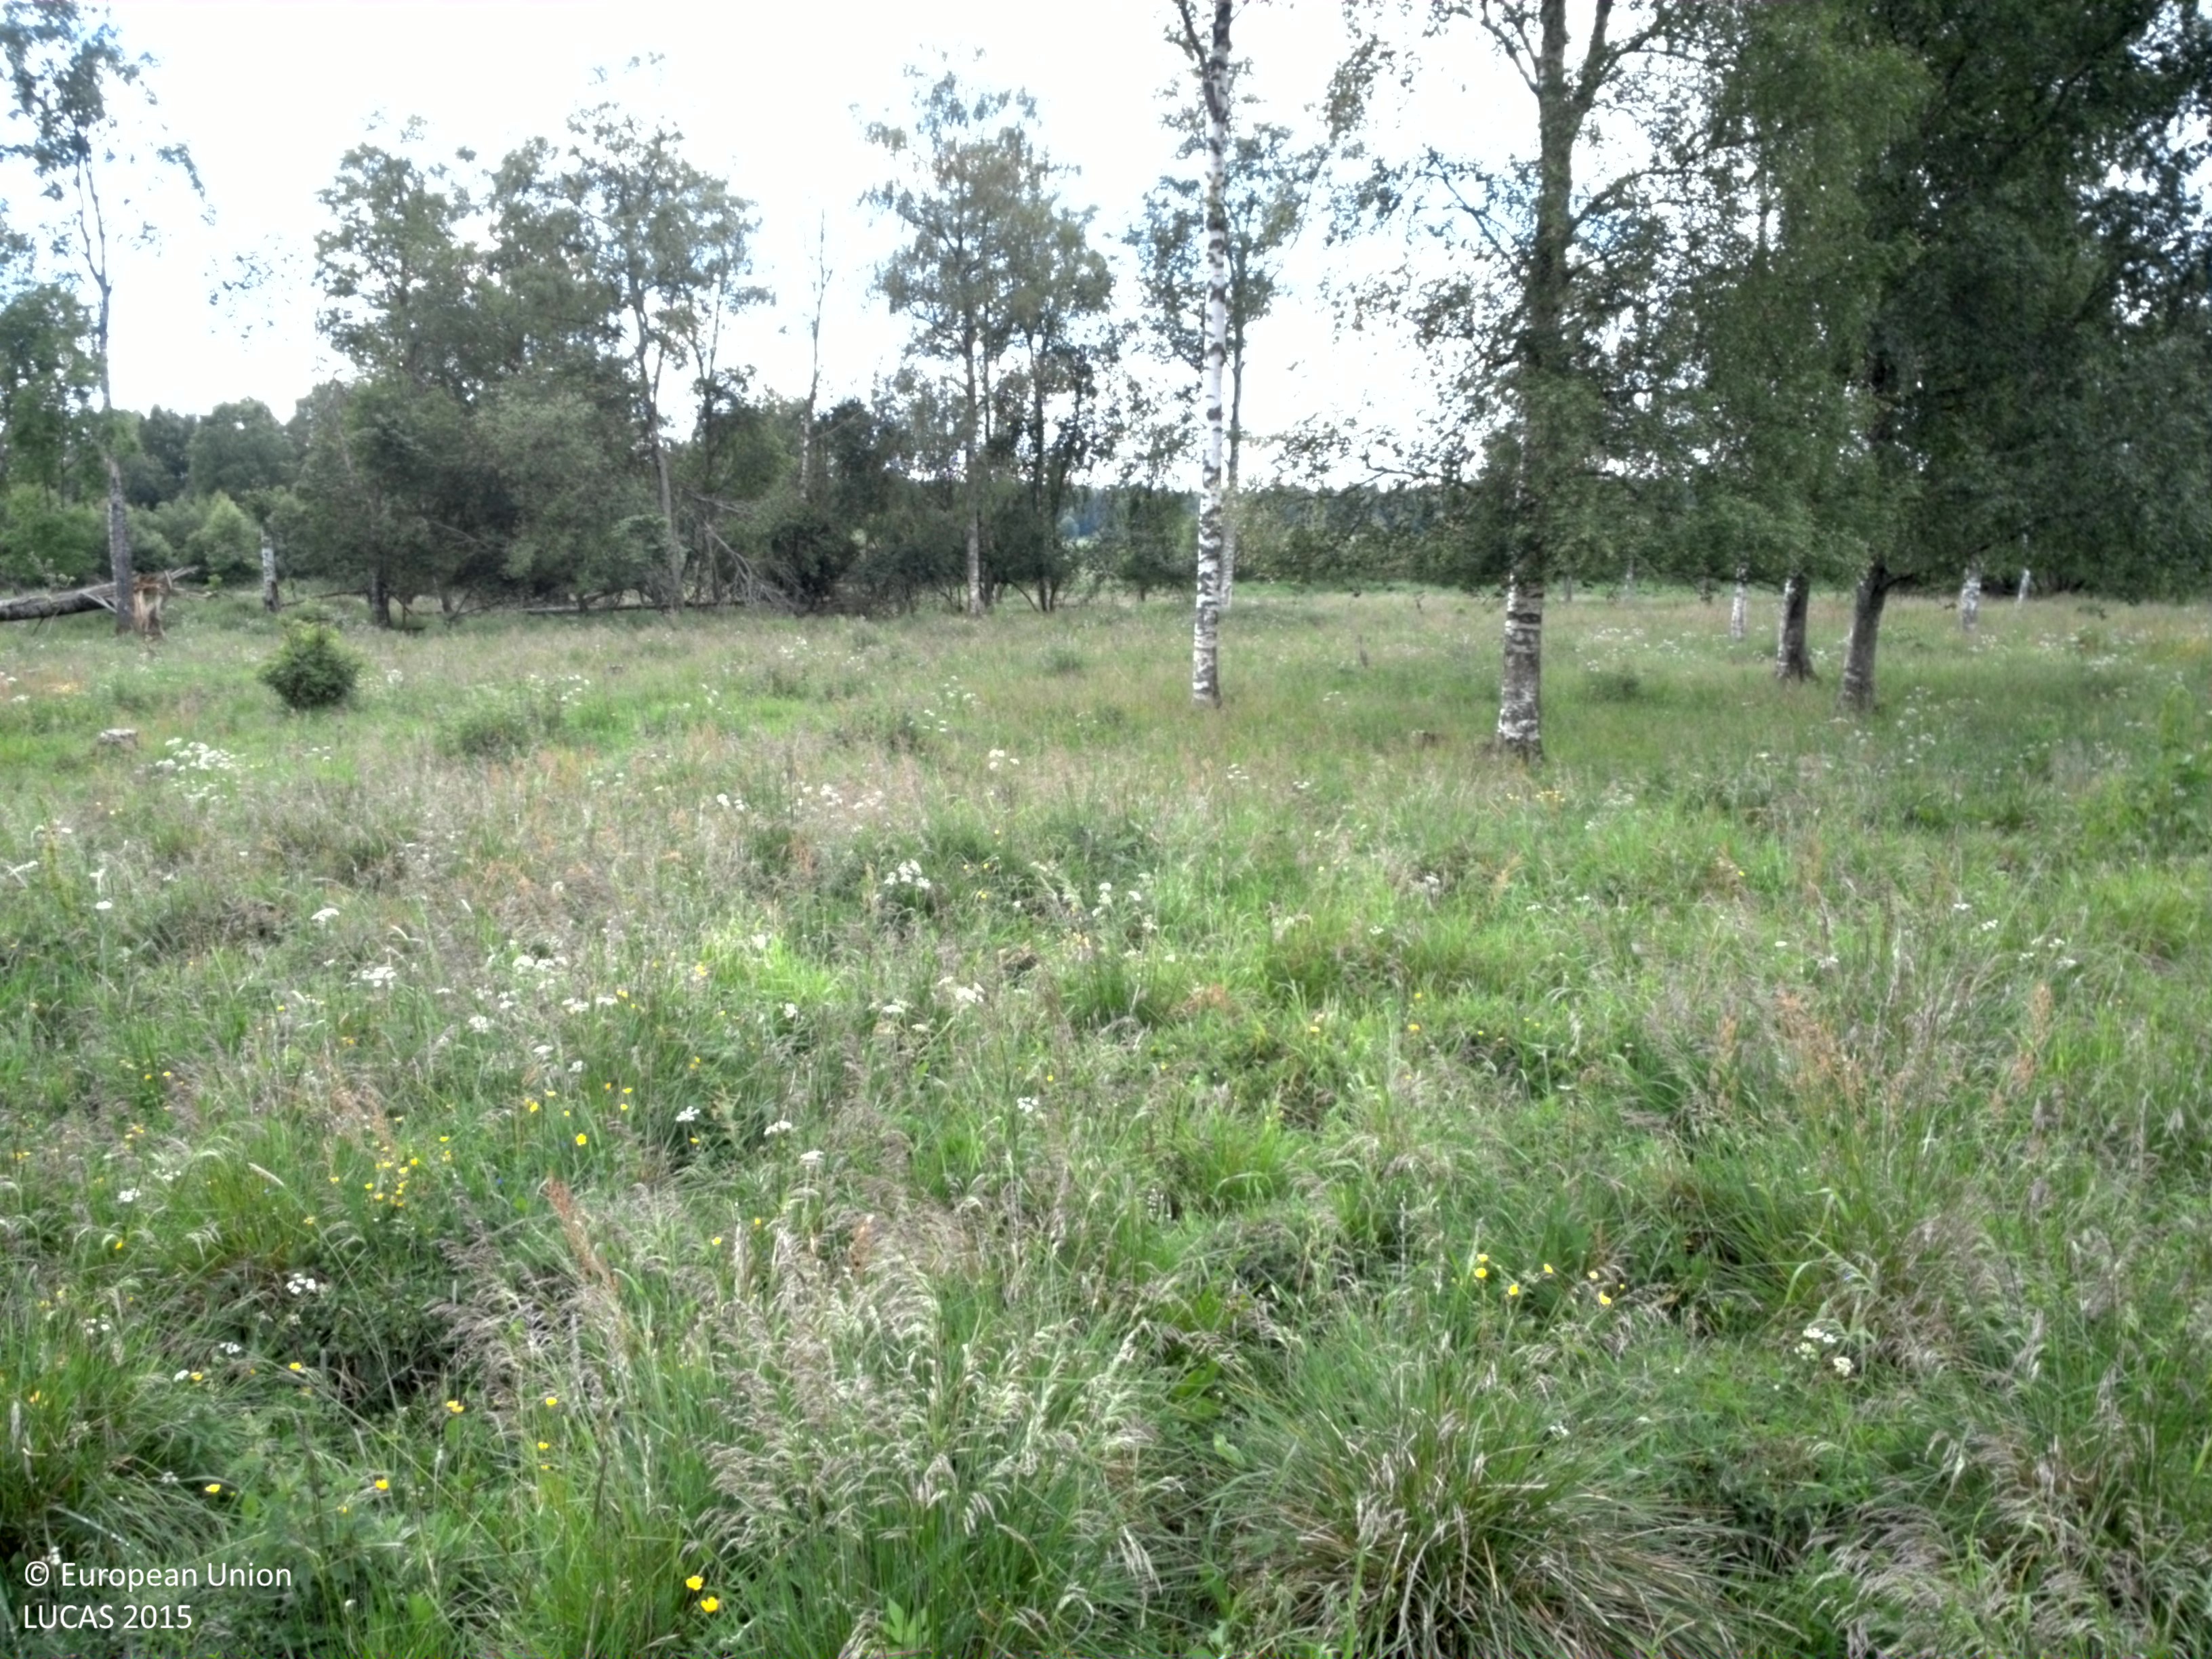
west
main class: Grassland
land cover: Grassland without tree/shrub cover
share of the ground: > 75 %
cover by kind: herbaceous plants 100 %
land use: Agriculture (excluding fallow land and kitchen gardens)
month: June
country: SE
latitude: 59.8617
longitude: 17.0096
